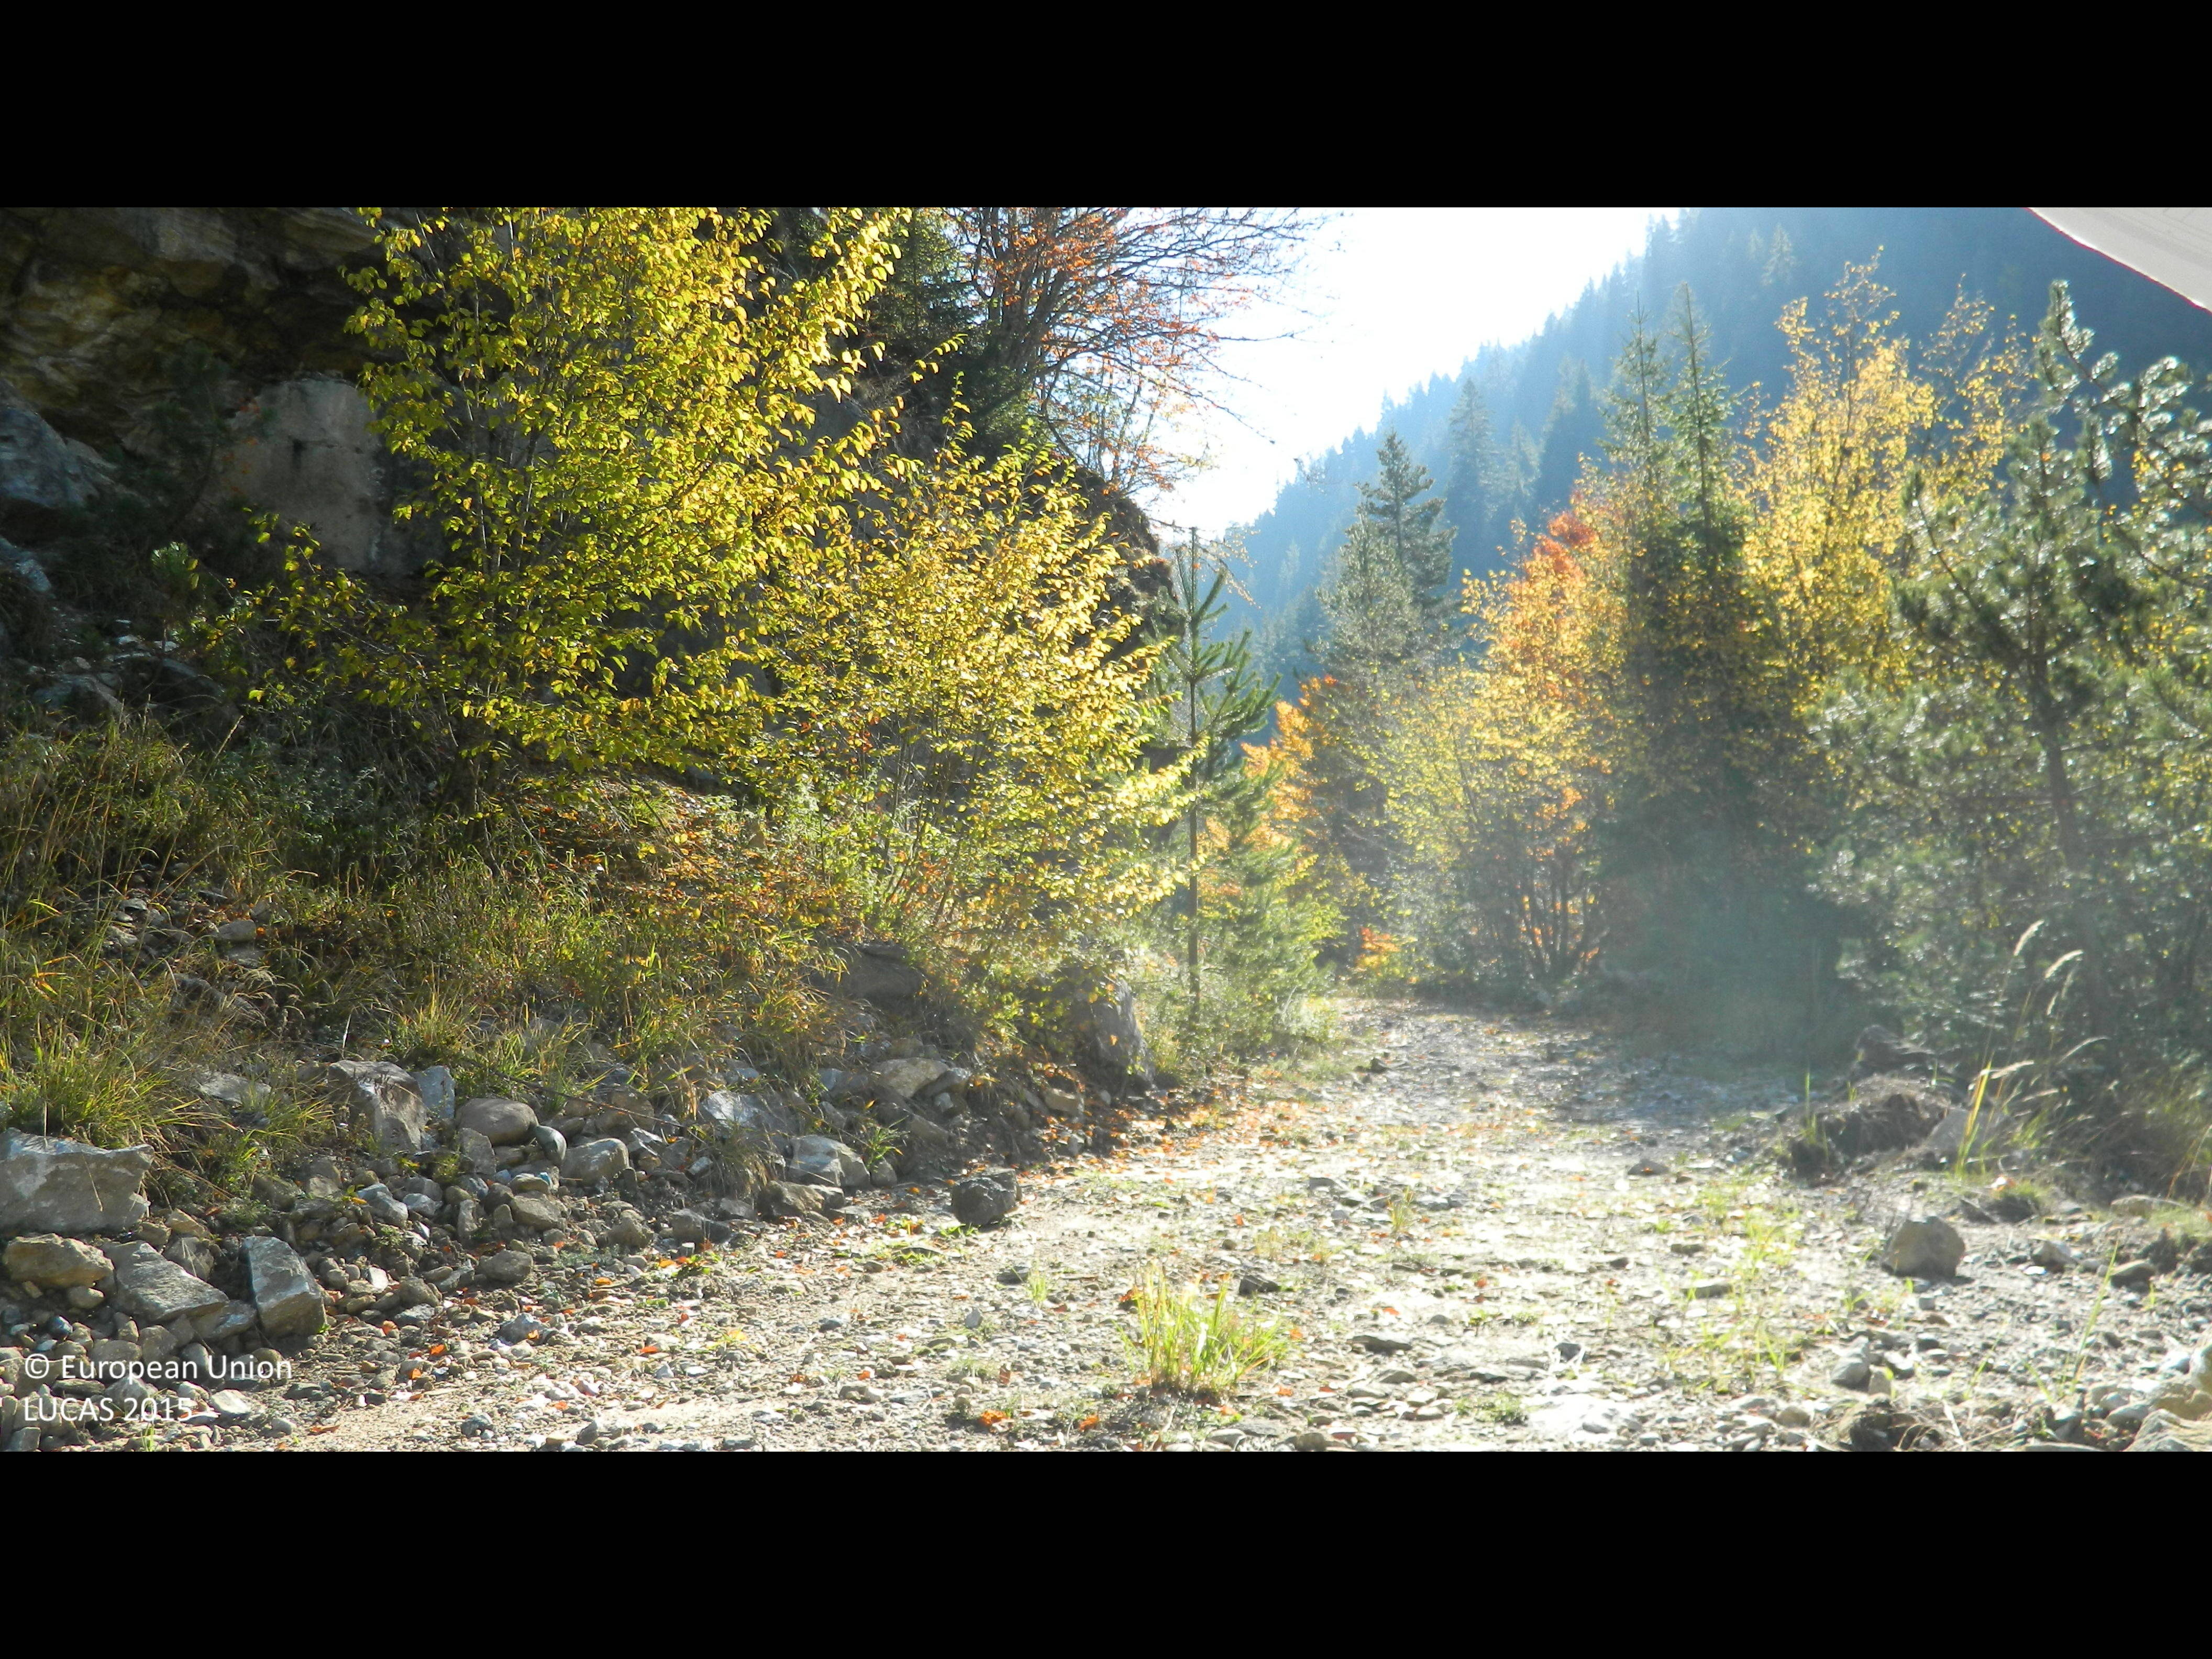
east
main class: Woodland
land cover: Spruce dominated coniferous woodland
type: alpine coniferous forest
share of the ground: > 75 %
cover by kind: coniferous forest trees 100 %
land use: Forestry
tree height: > 5 m
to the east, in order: Spruce dominated coniferous woodland
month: October
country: BG
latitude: 41.6467
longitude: 24.4605
